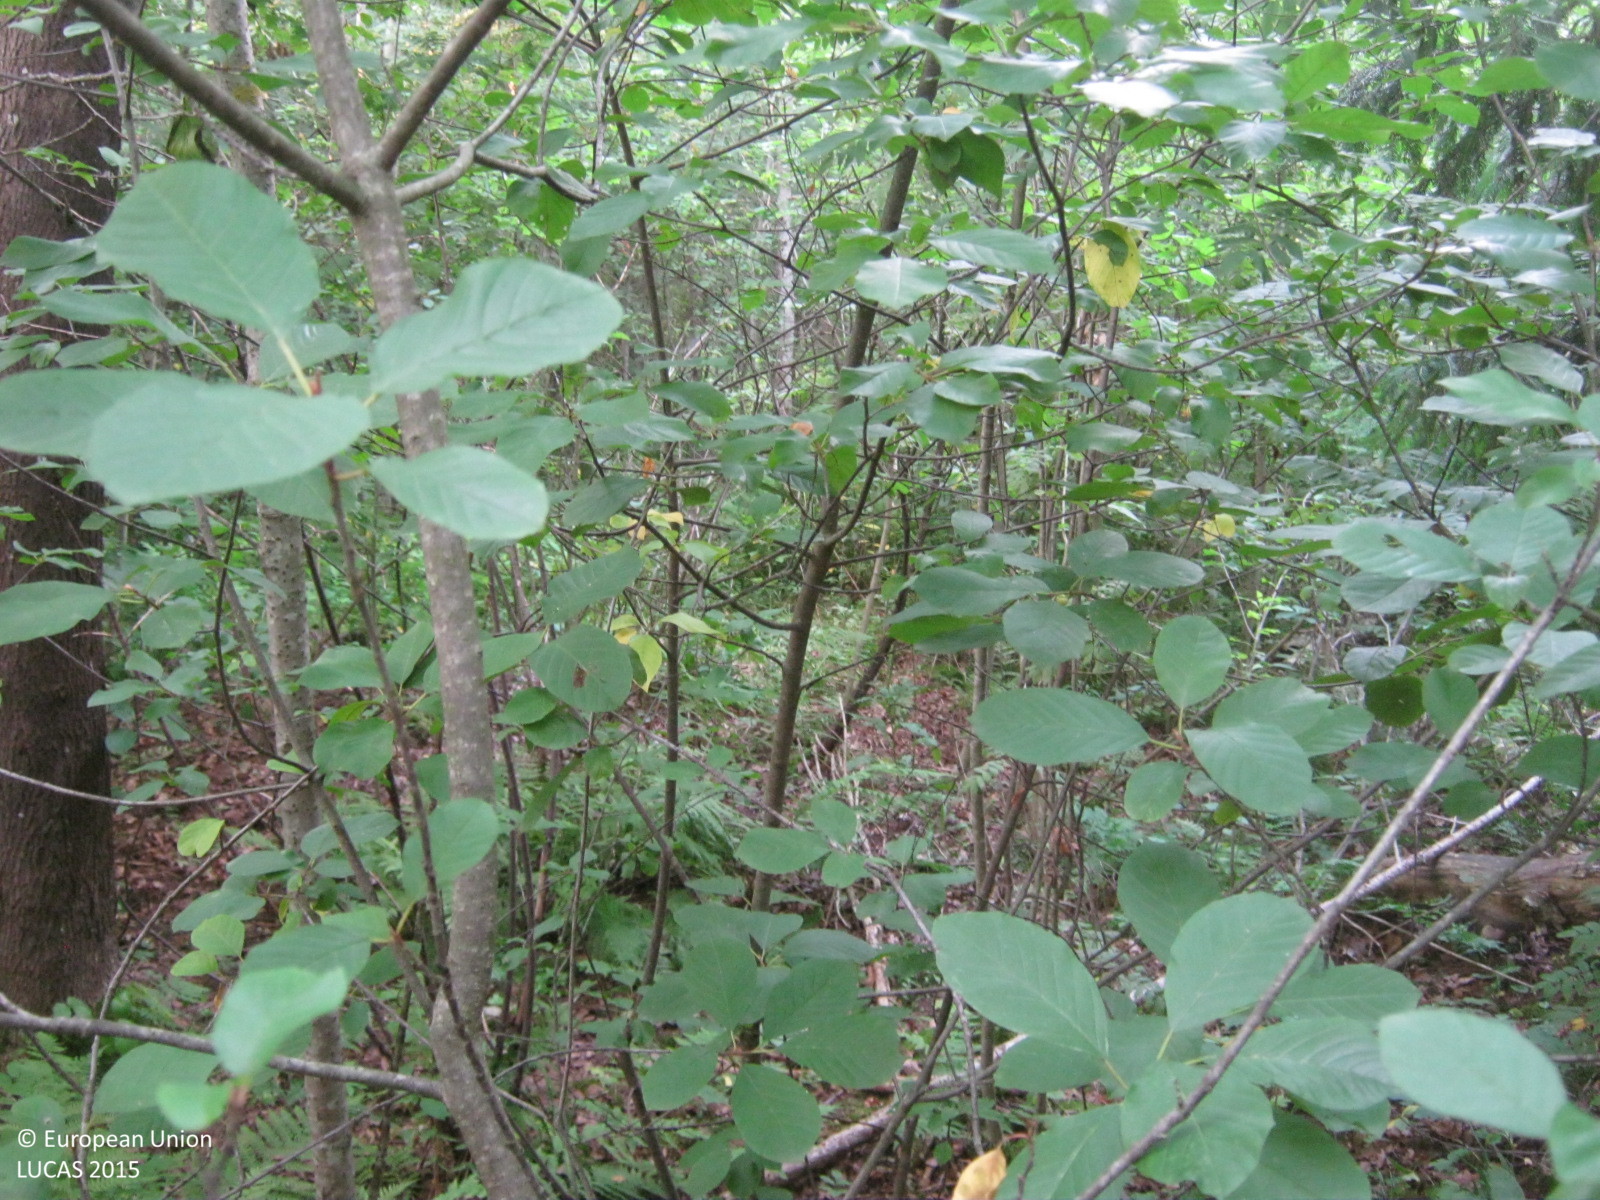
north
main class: Woodland
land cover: Broadleaved woodland
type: non-riverine alder, birch or aspen forest
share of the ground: > 75 %
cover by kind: broadleaved forest trees 80 %, coniferous forest trees 10 %, herbaceous plants 5 %, unconsolidated bare surface 5 %
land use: Forestry
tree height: > 5 m
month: August
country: LV
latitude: 57.3916
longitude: 24.6533
